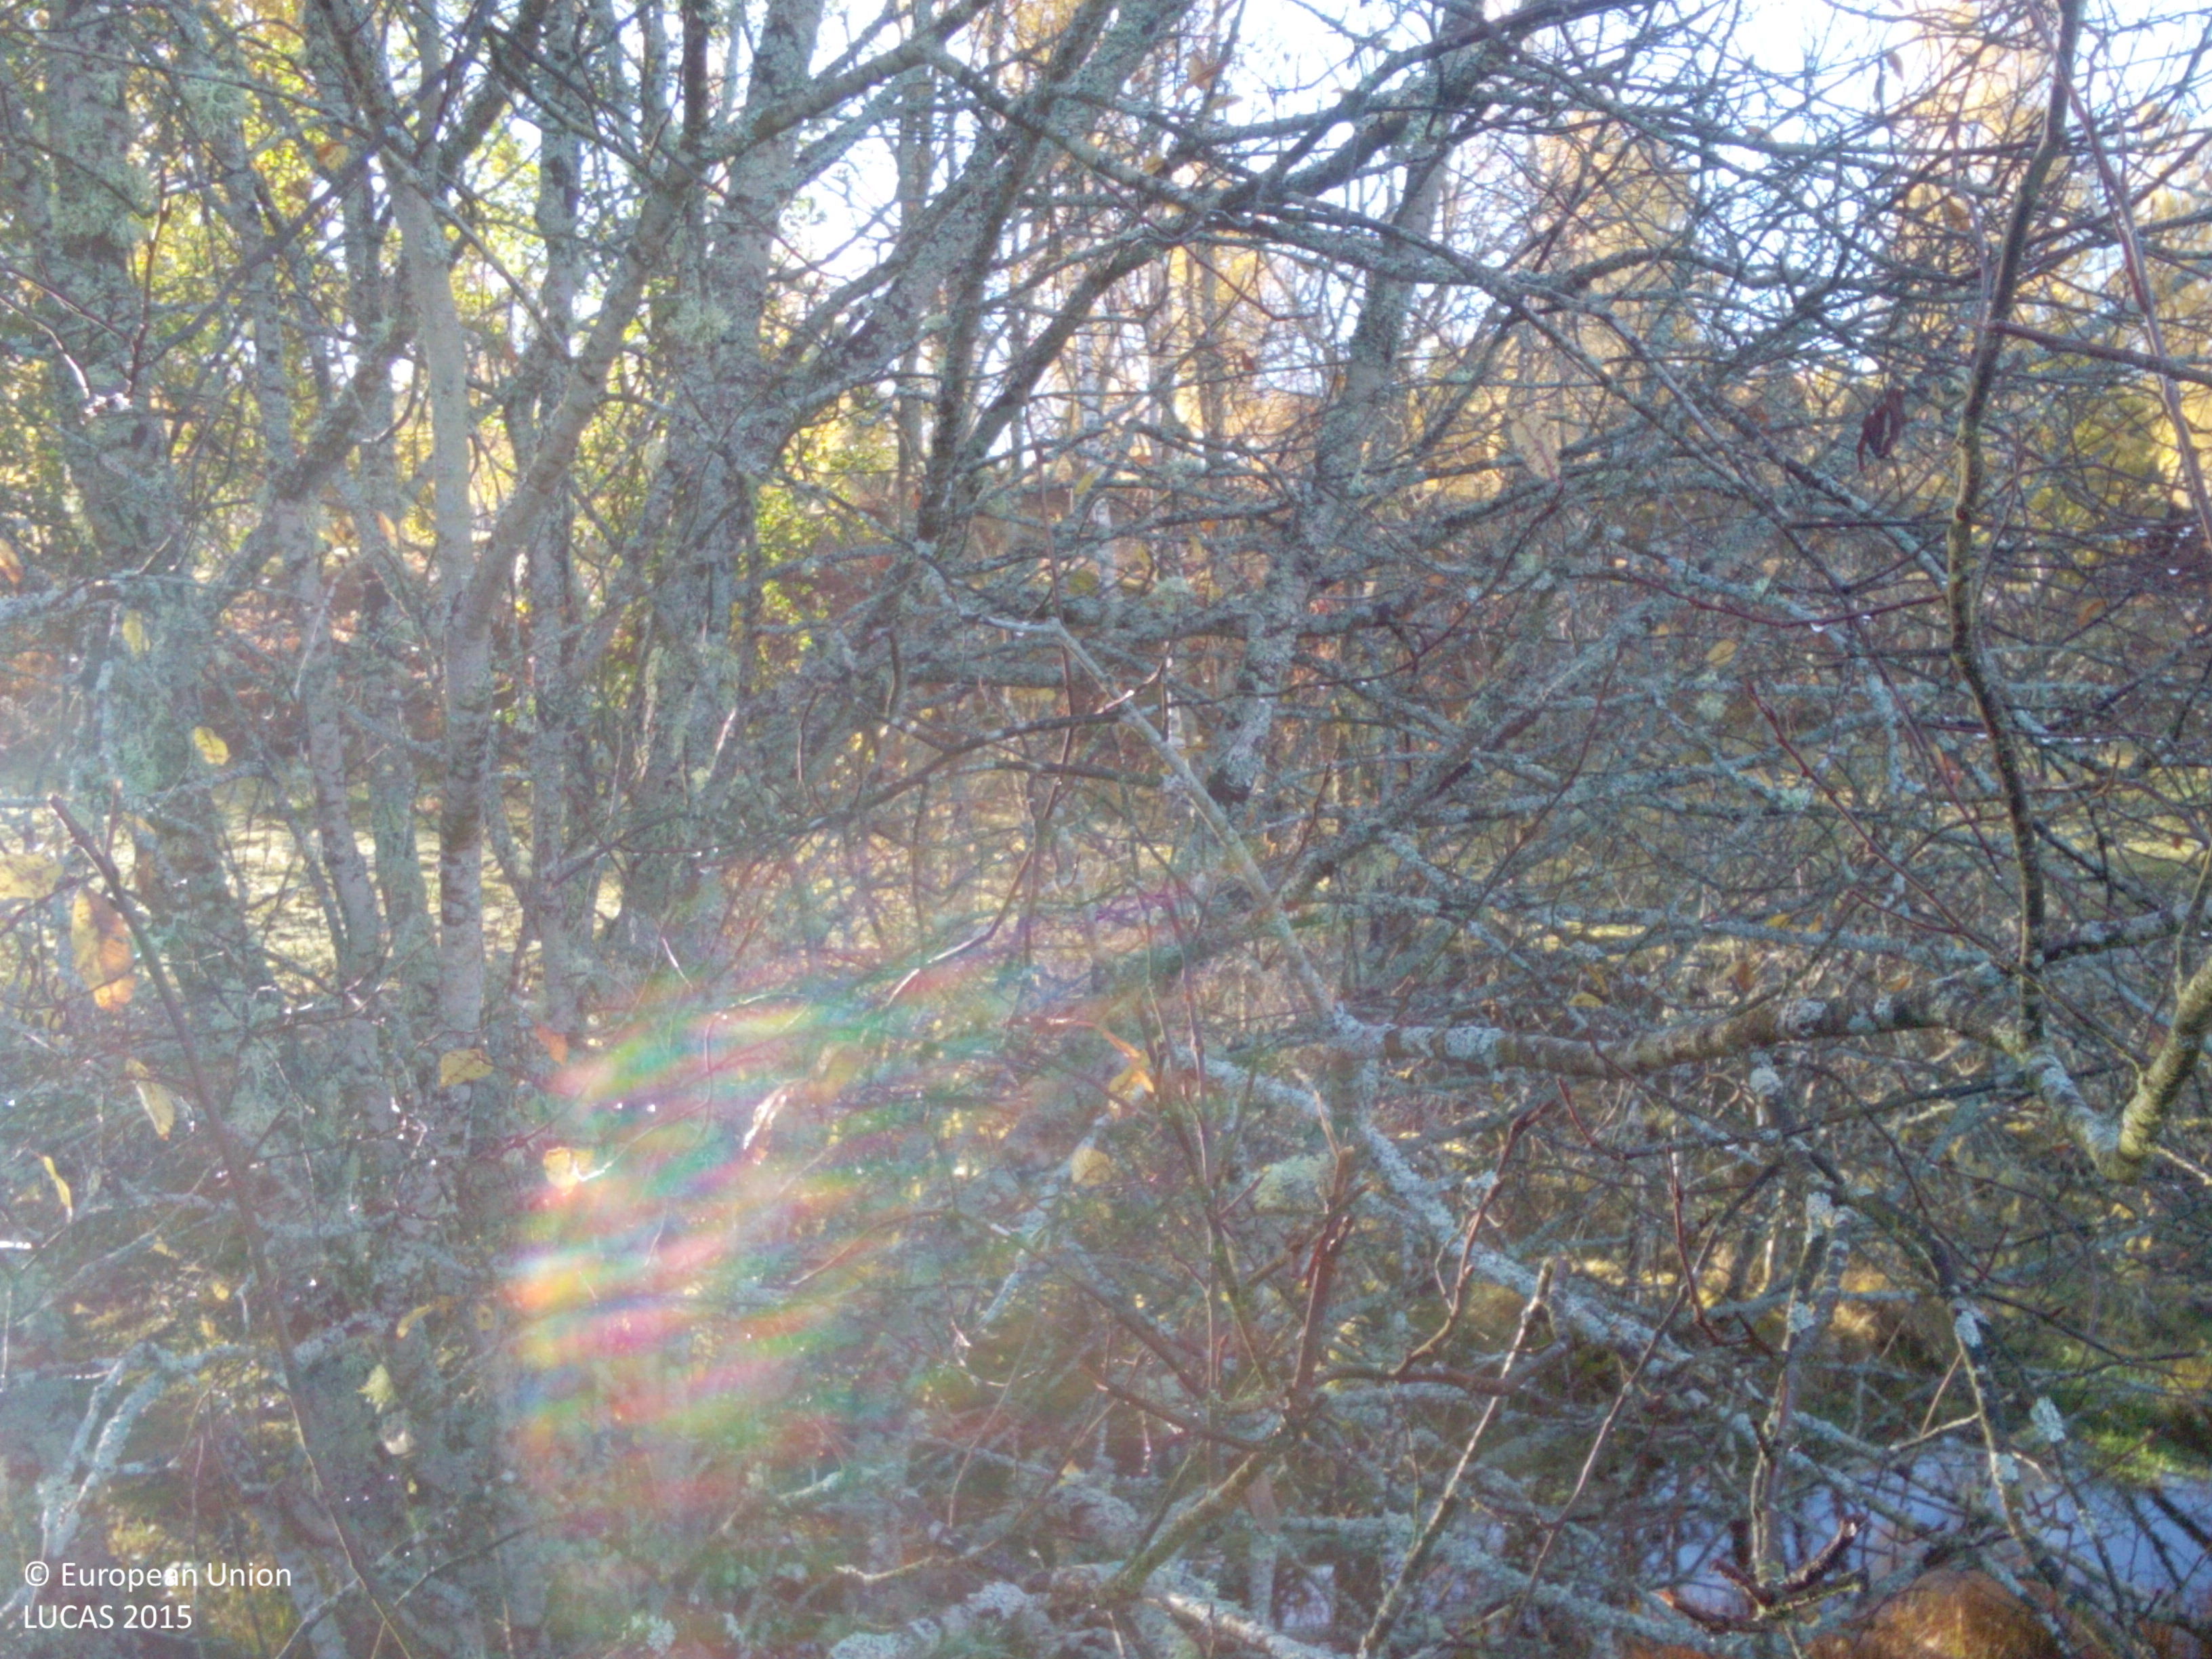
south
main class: Grassland
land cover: Grassland without tree/shrub cover
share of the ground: > 75 %
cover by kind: herbaceous plants 100 %
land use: Agriculture (excluding fallow land and kitchen gardens)
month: October
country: SE
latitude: 59.0831
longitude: 16.2929
